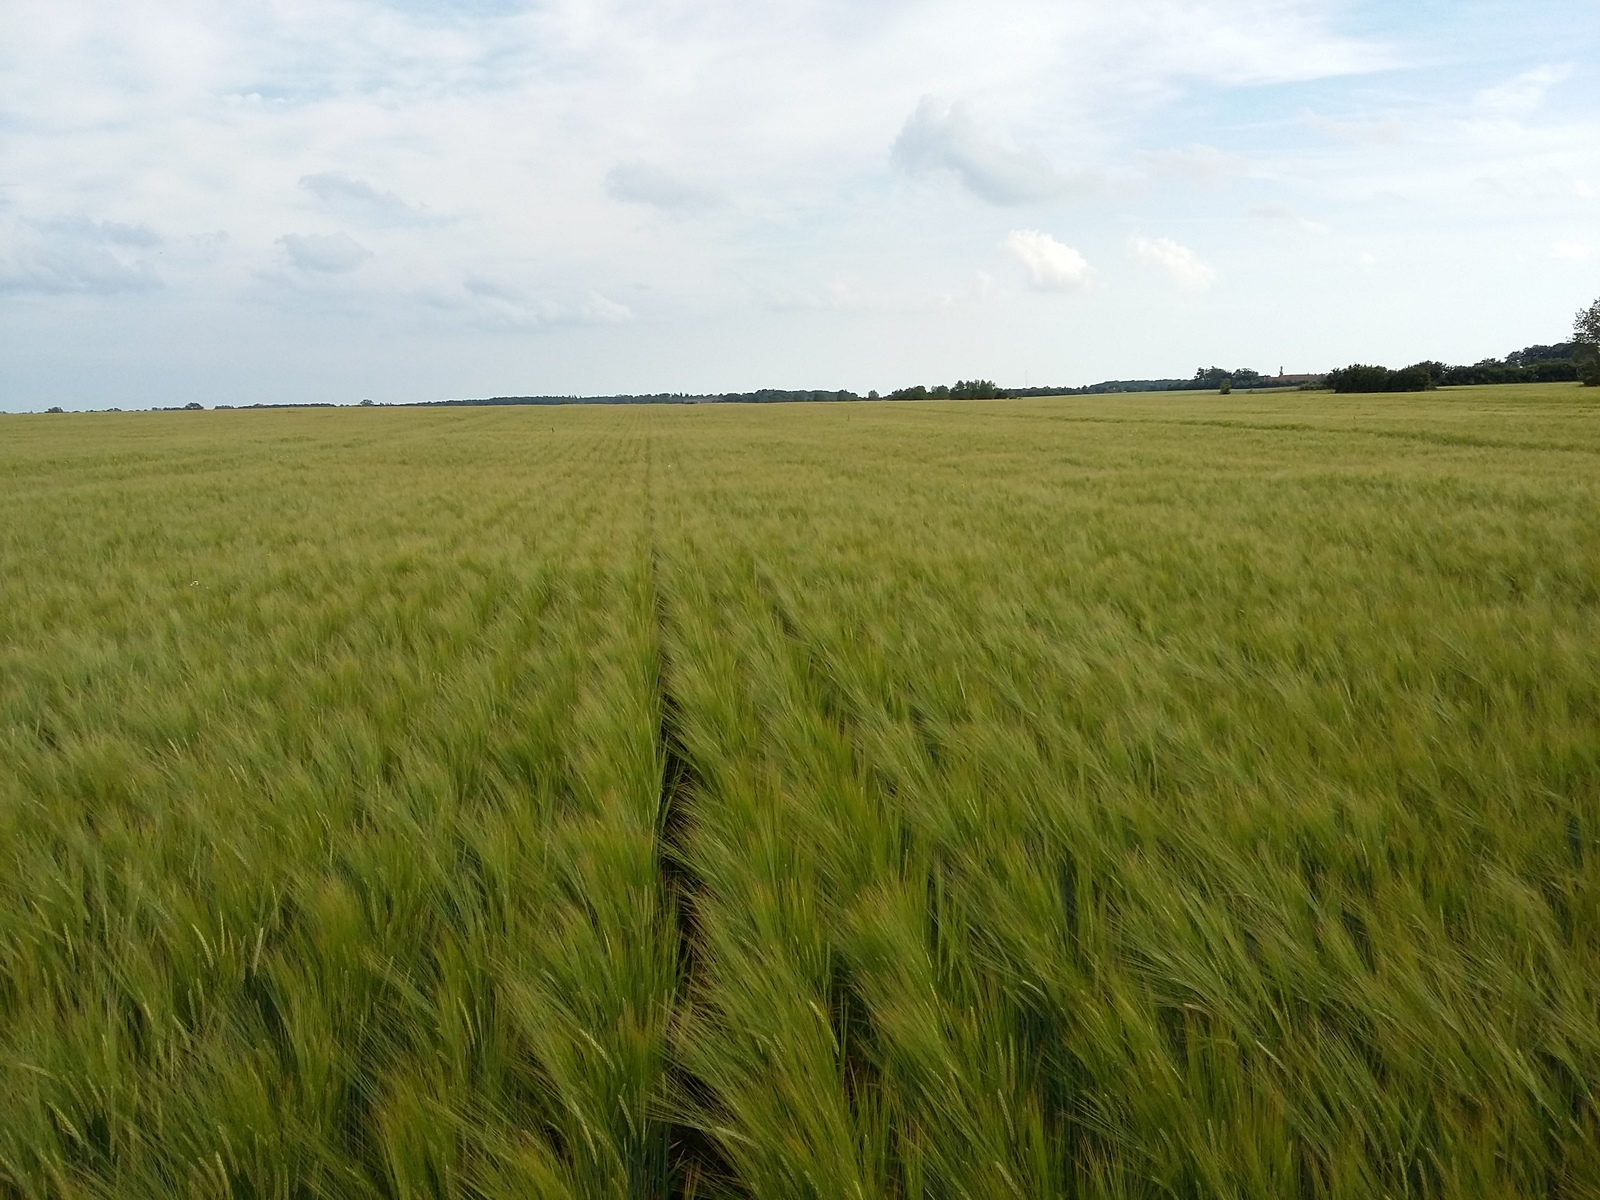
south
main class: Cropland
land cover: Barley
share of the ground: > 75 %
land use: Agriculture (excluding fallow land and kitchen gardens)
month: June
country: DK
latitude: 54.8056
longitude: 12.0057
